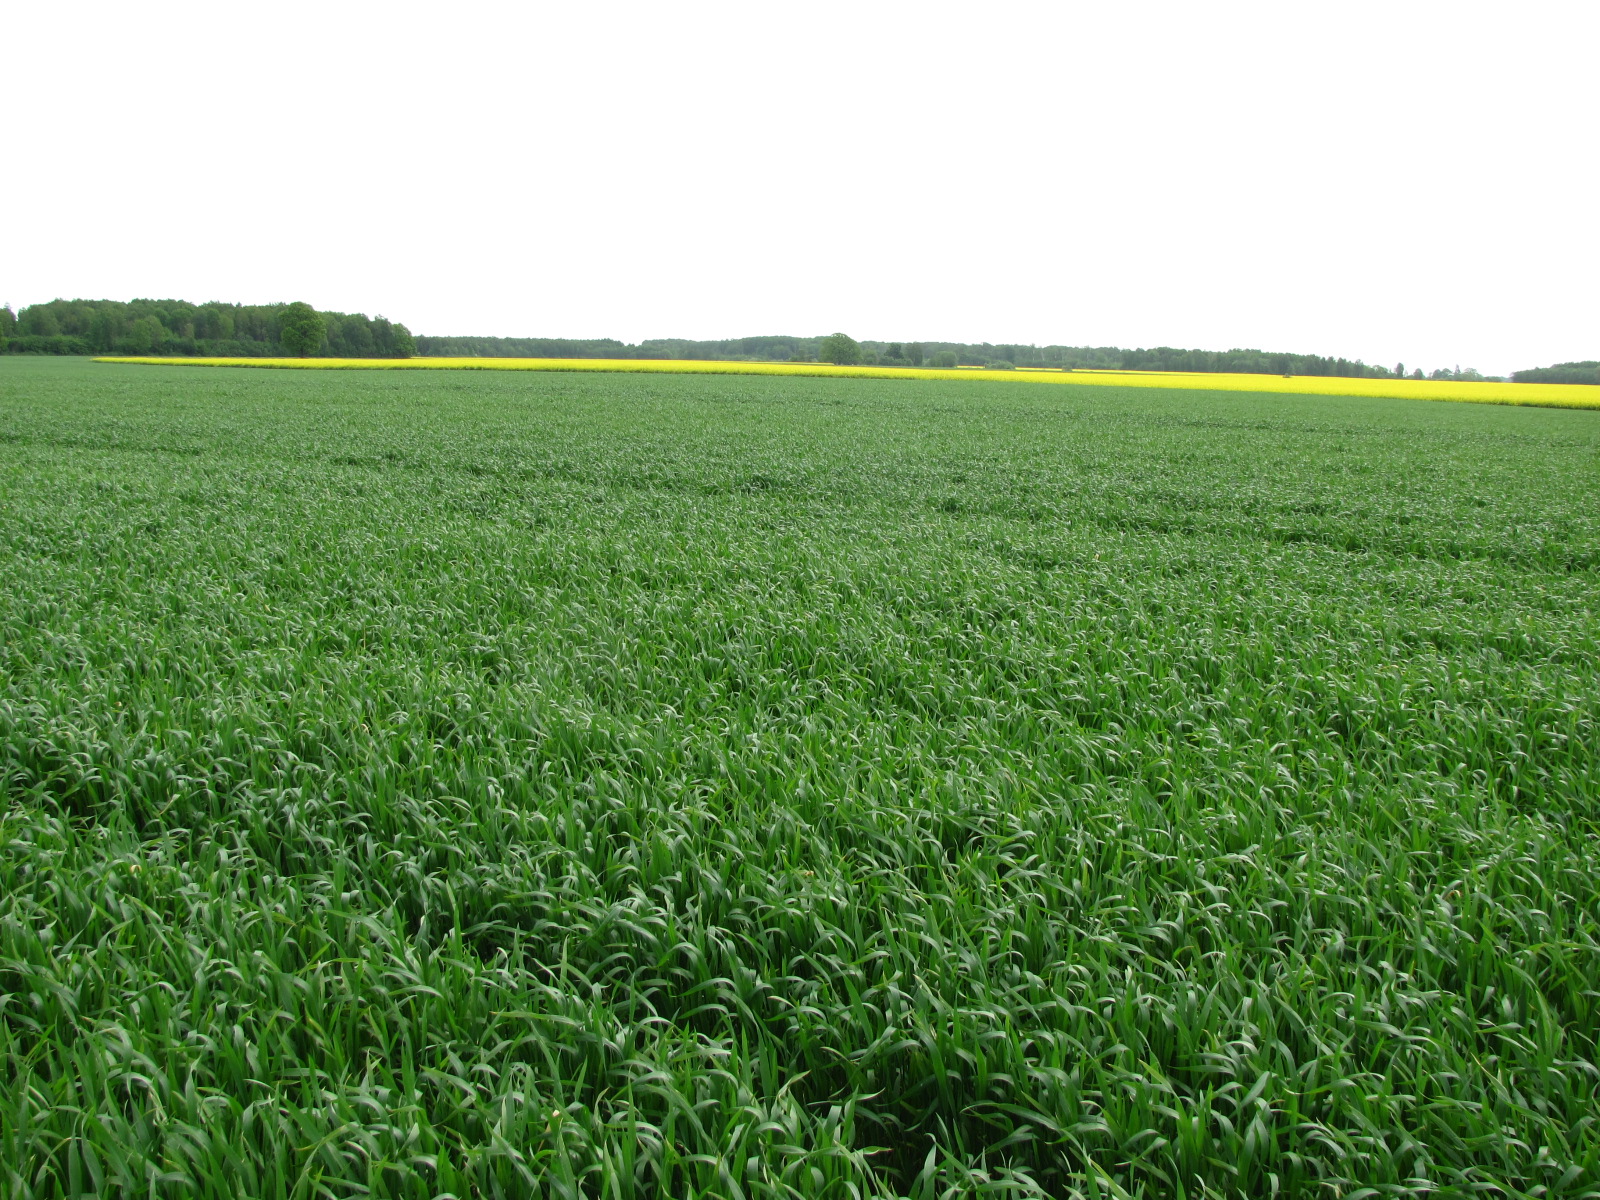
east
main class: Cropland
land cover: Common wheat
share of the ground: > 75 %
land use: Agriculture (excluding fallow land and kitchen gardens)
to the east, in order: Common wheat; Rape and turnip rape
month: May
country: LV
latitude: 56.4440
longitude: 24.1194
